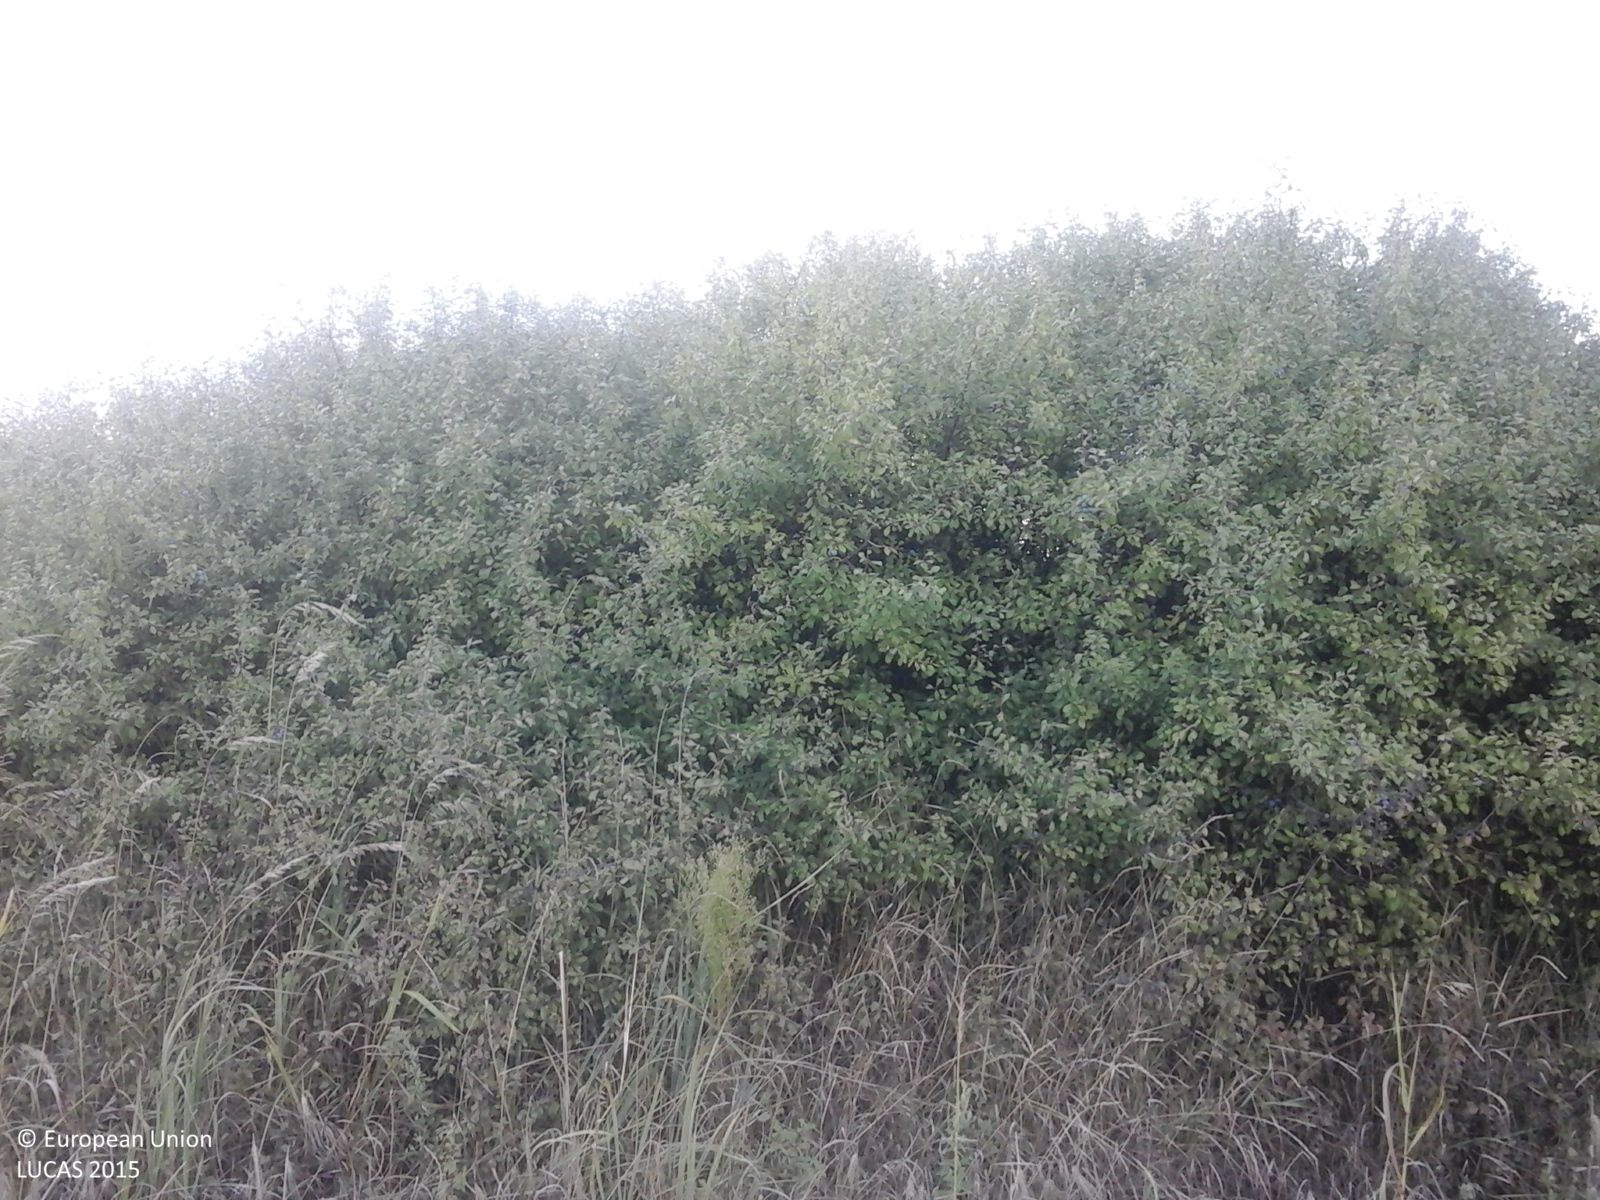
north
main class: Cropland
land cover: Common wheat
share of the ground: 50 - 75 %
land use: Agriculture (excluding fallow land and kitchen gardens)
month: August
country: RO
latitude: 45.3407
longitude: 21.2201
